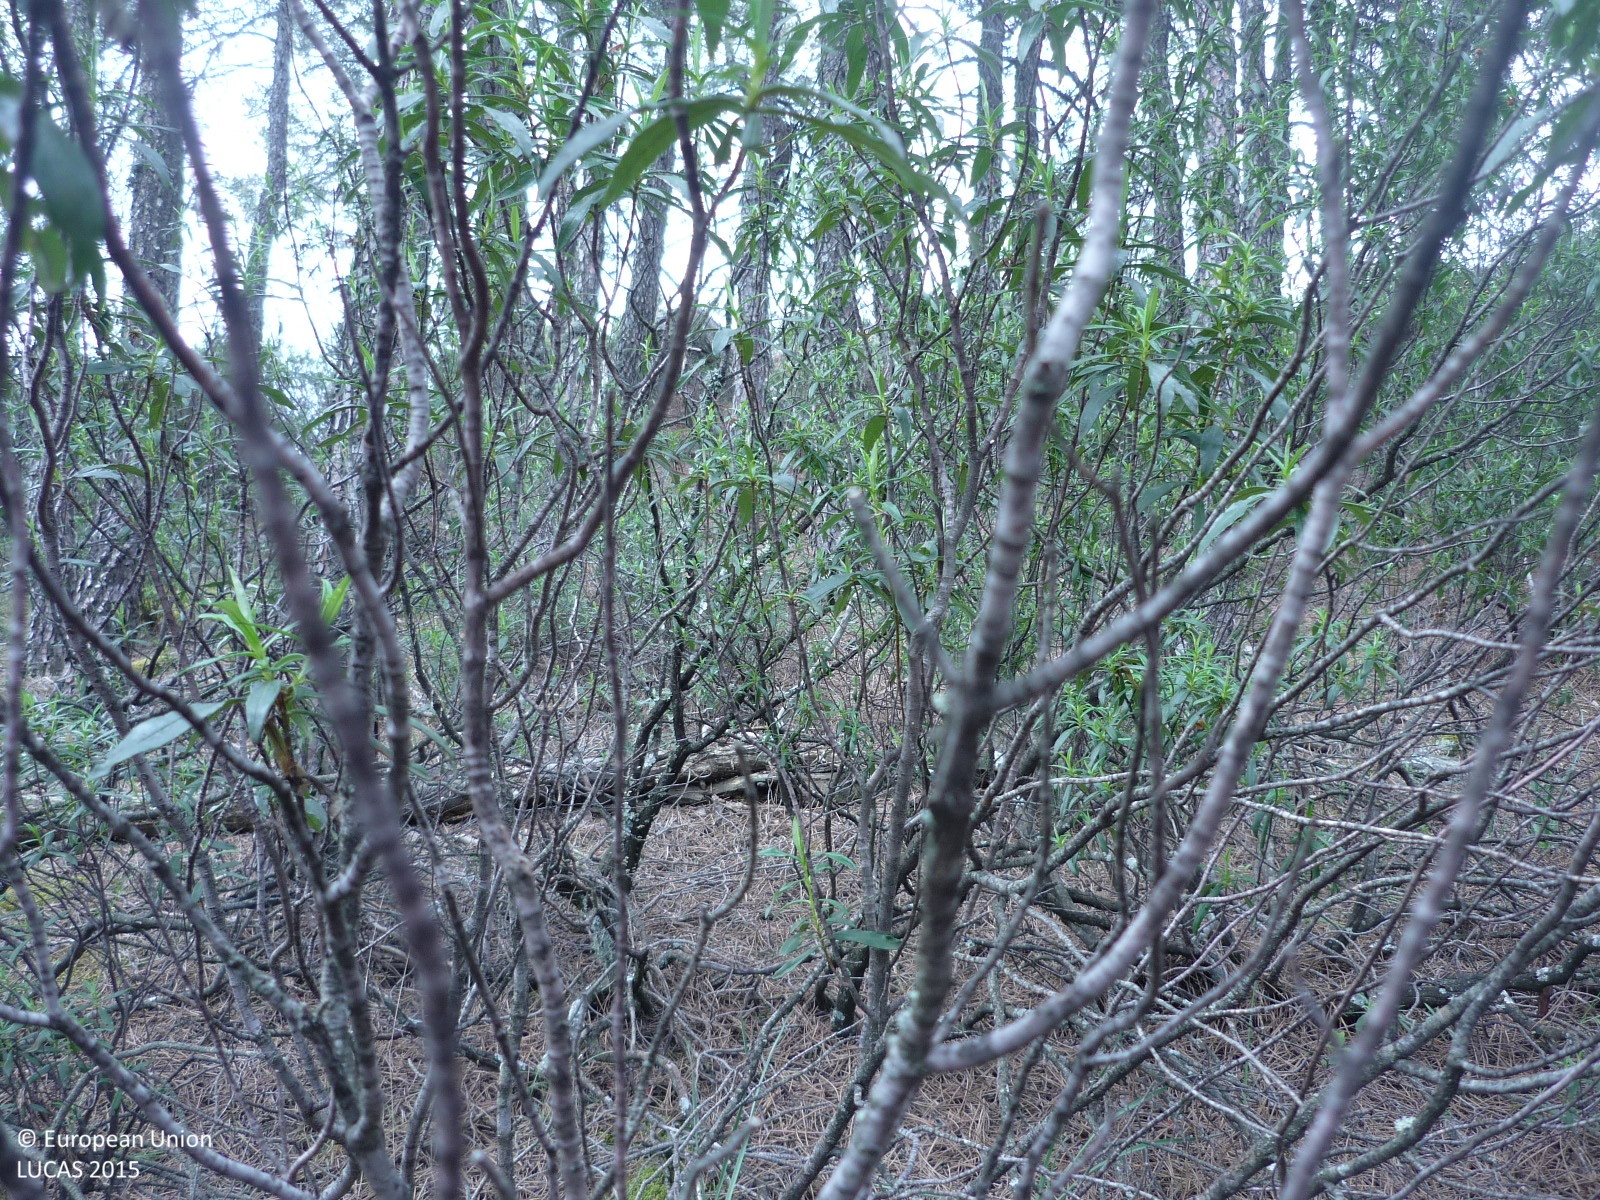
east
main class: Woodland
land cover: Pine dominated coniferous woodland
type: coniferous forest of the mediterranean region
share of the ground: > 75 %
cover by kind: coniferous forest trees 90 %, shrubs 10 %
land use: Forestry
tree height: > 5 m
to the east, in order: Pine dominated coniferous woodland
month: April
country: ES
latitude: 40.8907
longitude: -3.4641
